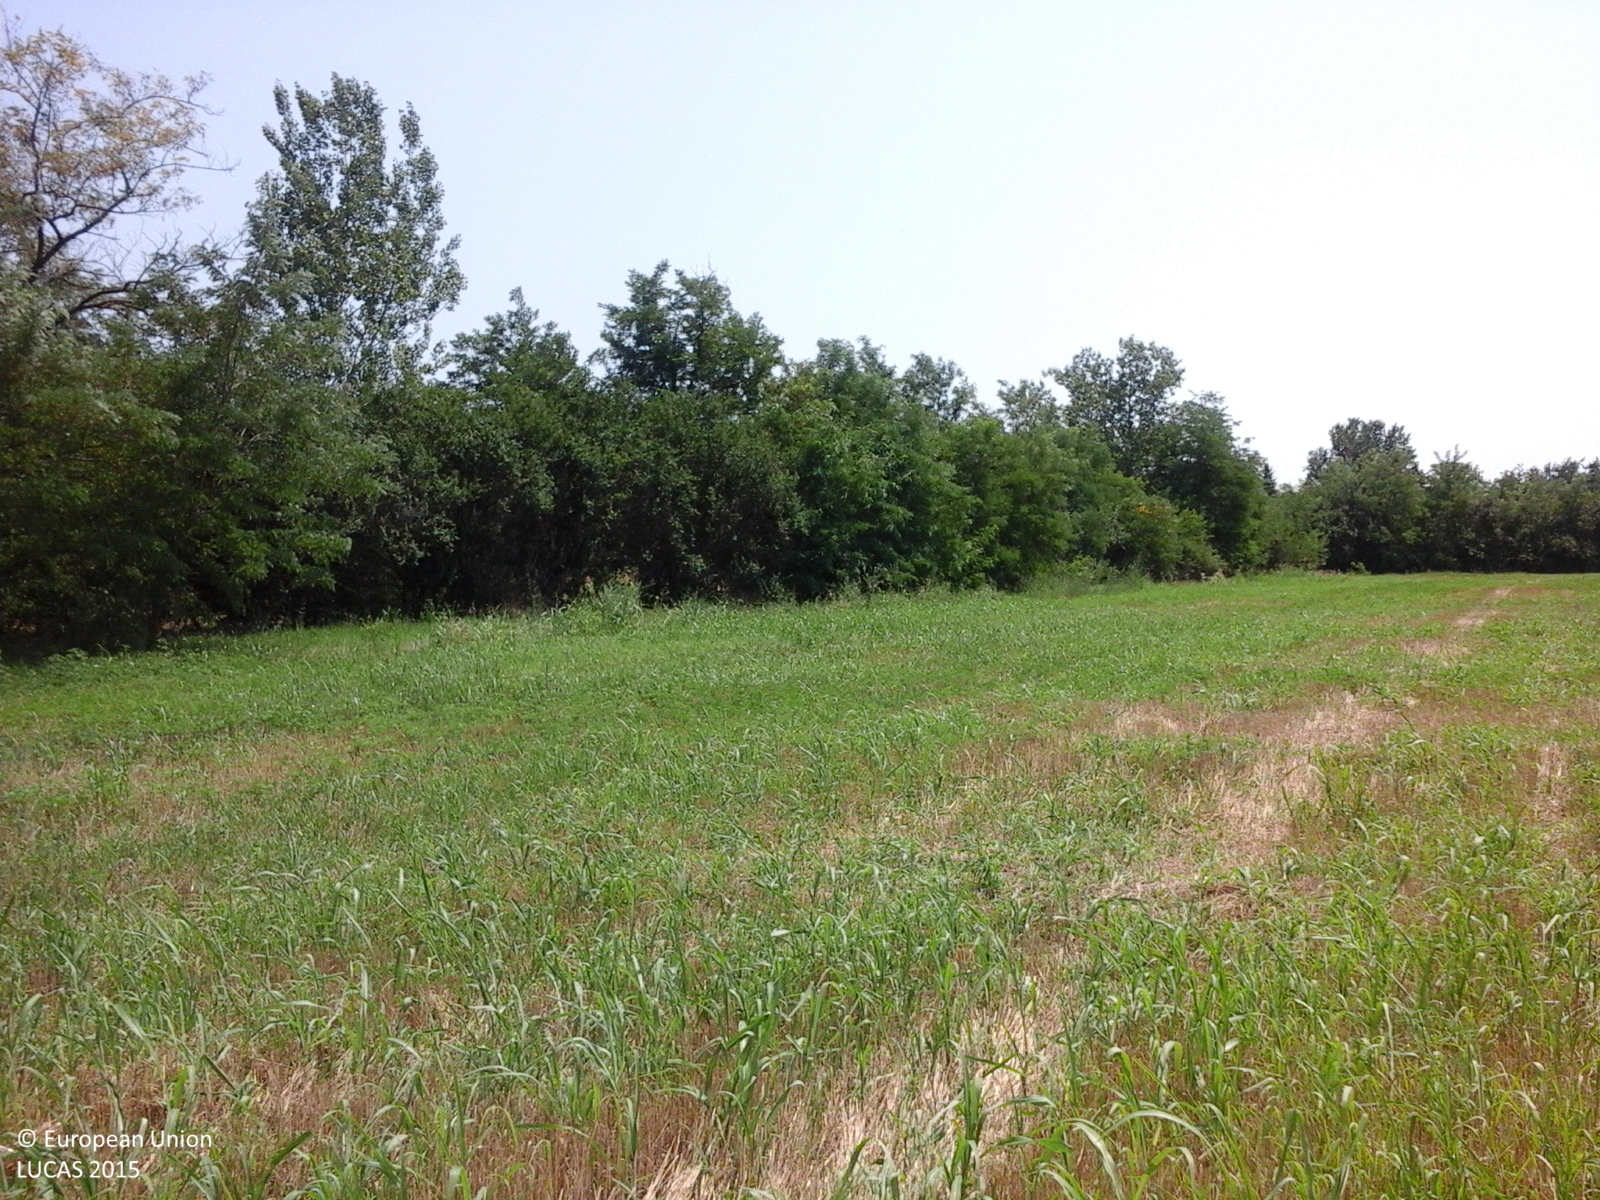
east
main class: Cropland
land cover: Common wheat
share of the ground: < 10 %
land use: Agriculture (excluding fallow land and kitchen gardens)
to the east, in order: Common wheat; Broadleaved woodland; Grassland with sparse tree/shrub cover; Grassland without tree/shrub cover; Single bushes/trees; Grassland without tree/shrub cover; Tracks; Grassland with sparse tree/shrub cover; Artificial constructions in urban areas; Broadleaved woodland
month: July
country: RO
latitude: 44.6928
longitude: 26.7168
